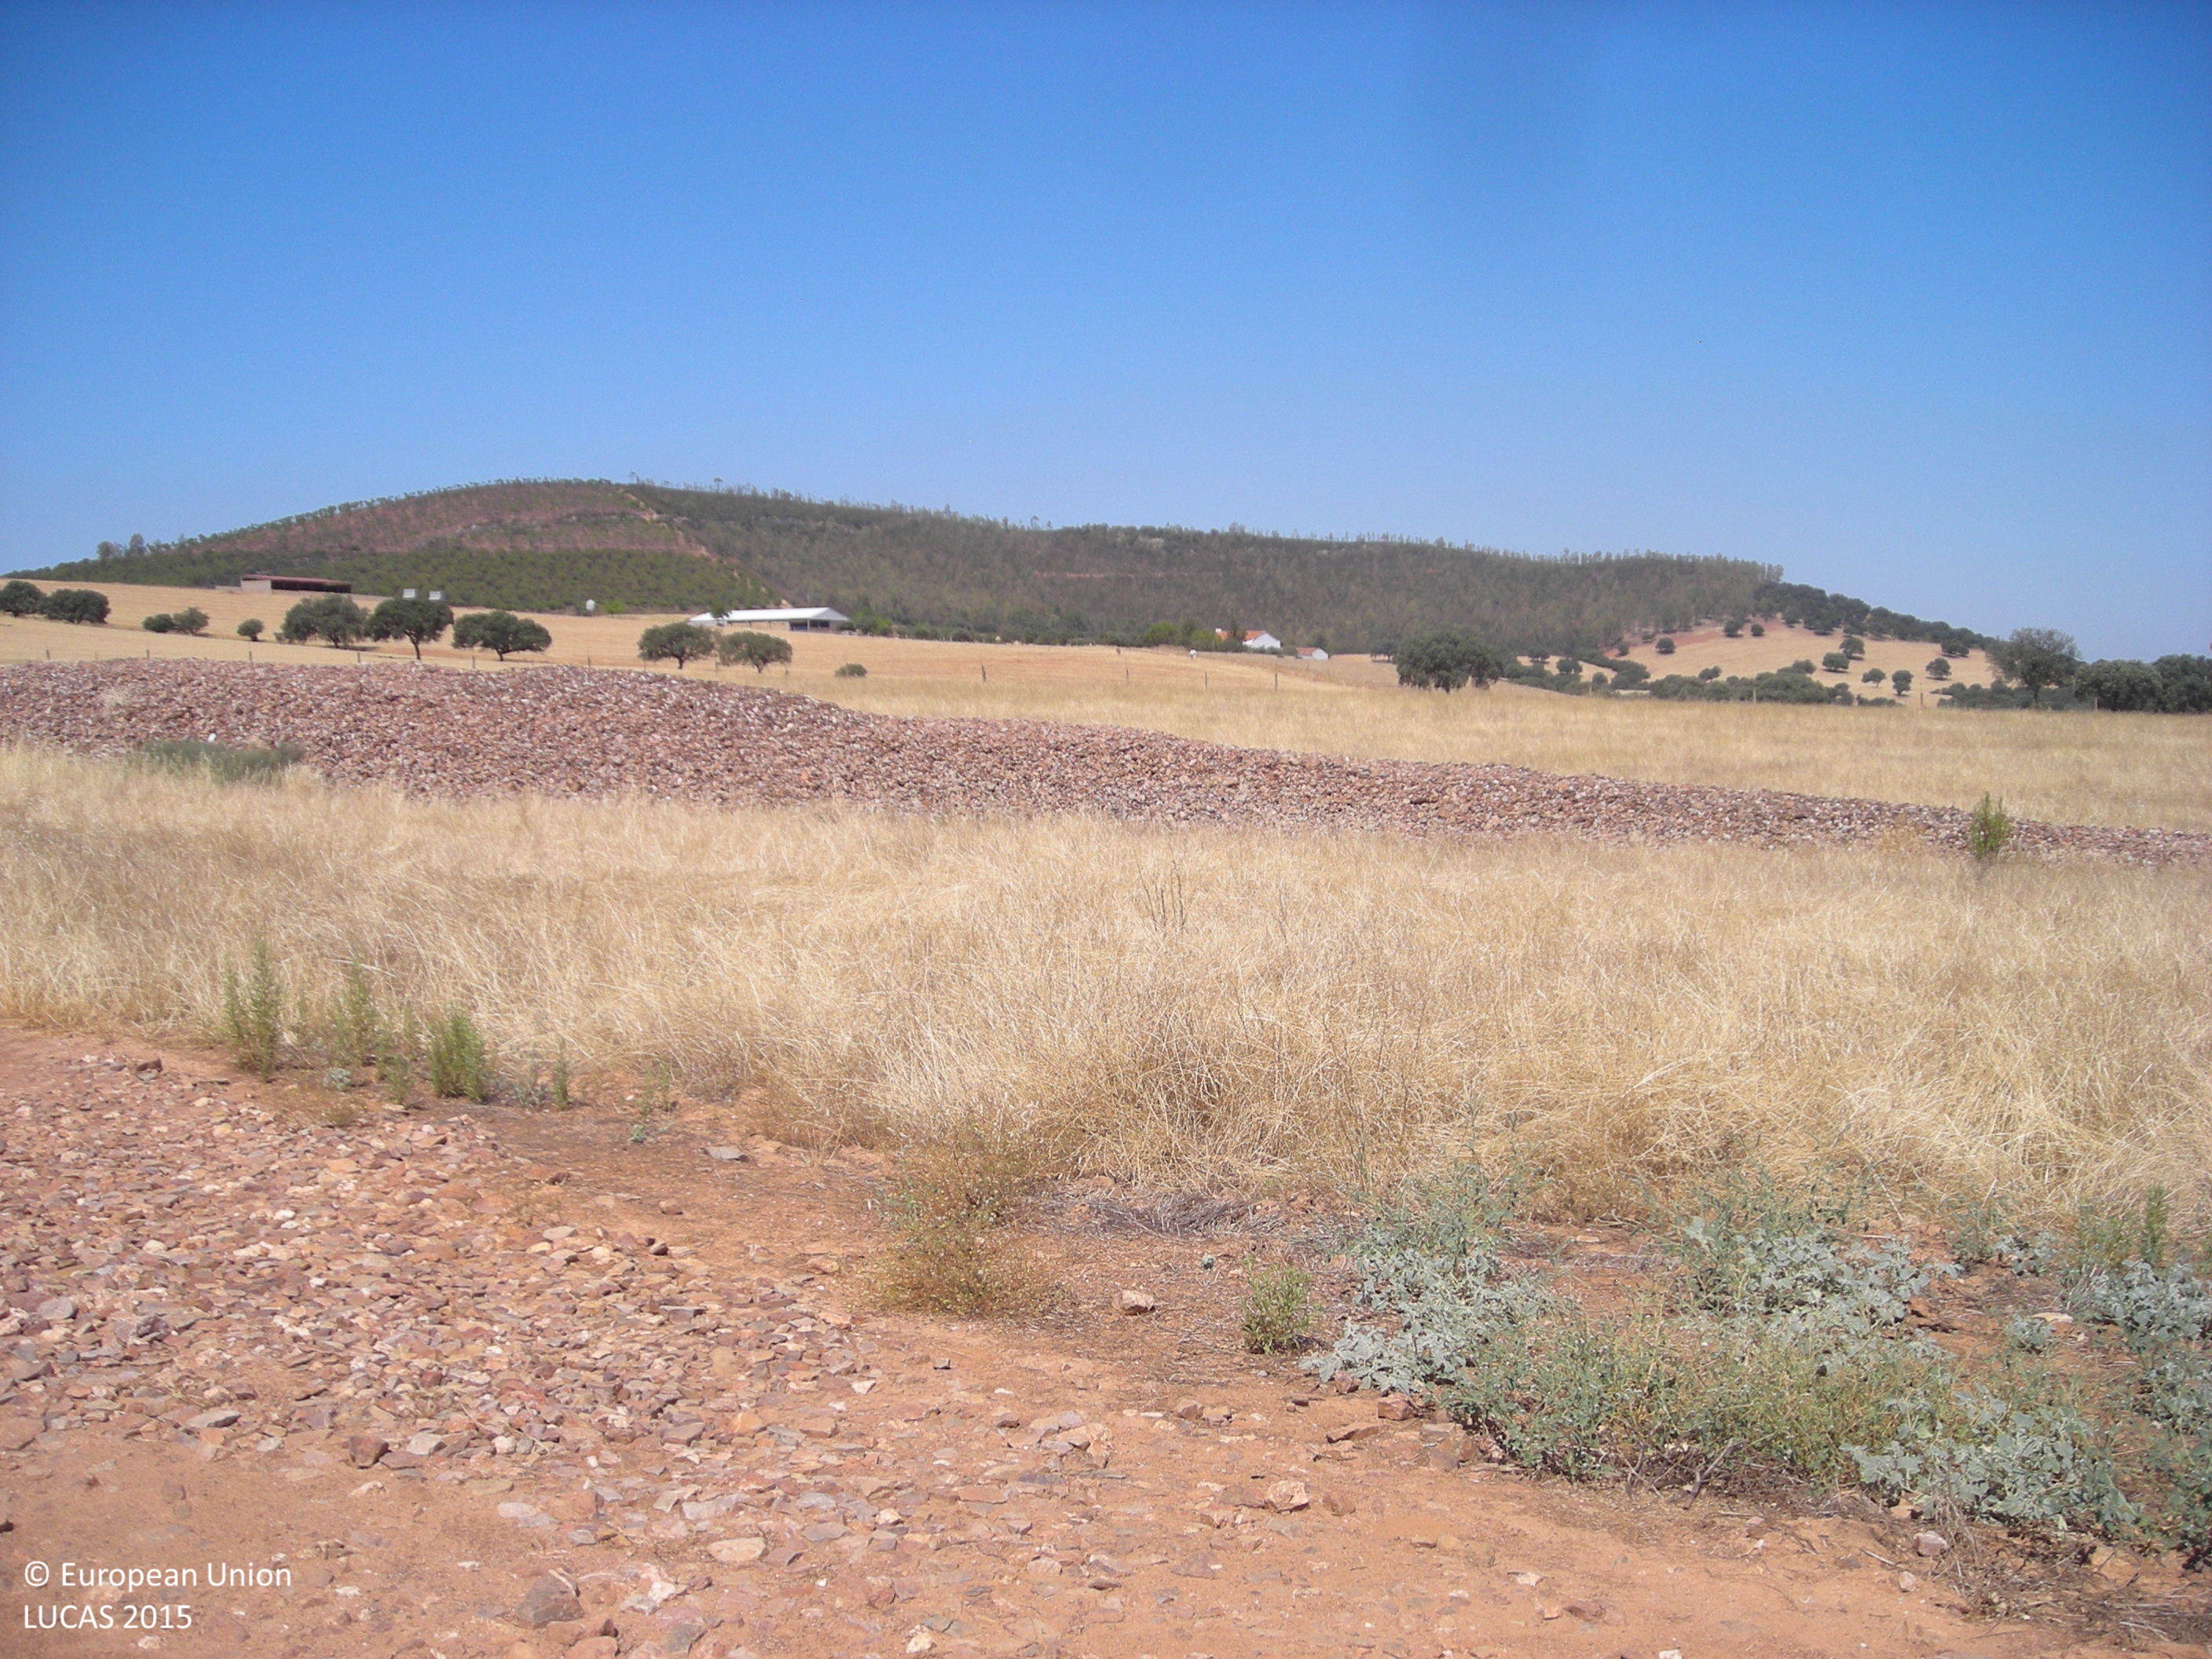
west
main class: Woodland
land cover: Broadleaved woodland
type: broadleaved evergreen forest
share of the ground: 25 - 50 %
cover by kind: broadleaved forest trees 40 %, shrubs 30 %, herbaceous plants 30 %
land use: Forestry
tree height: > 5 m
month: July
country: ES
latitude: 38.7638
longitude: -5.8704
